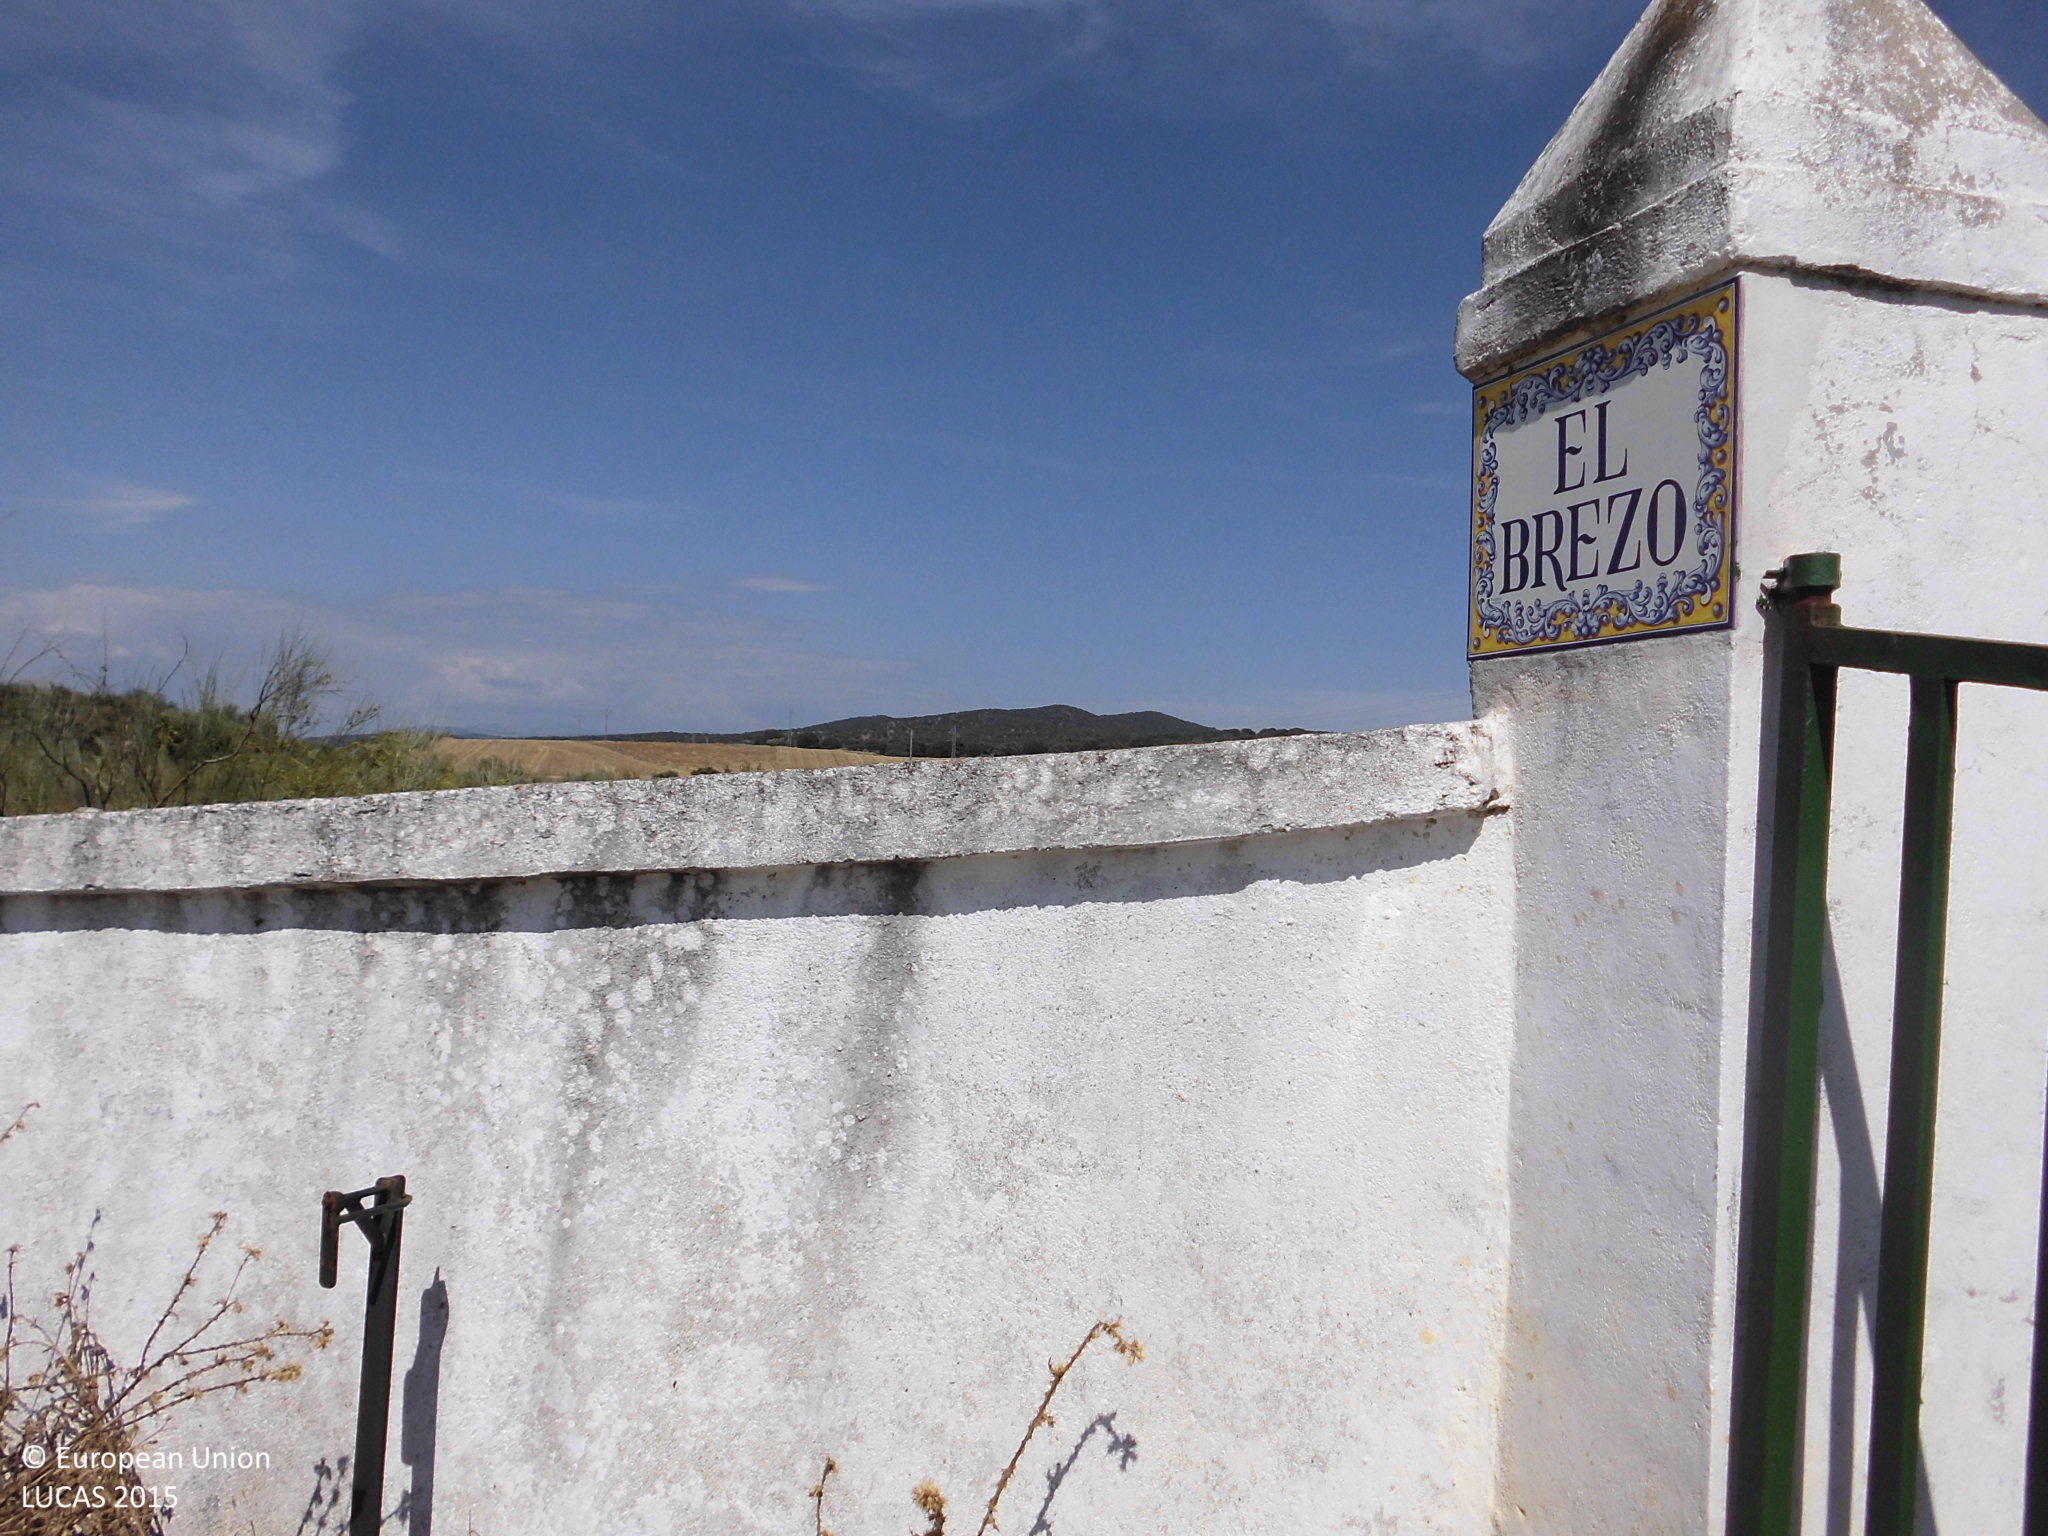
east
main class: Woodland
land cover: Broadleaved woodland
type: broadleaved evergreen forest
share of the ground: 50 - 75 %
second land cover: Grassland without tree/shrub cover
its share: > 75 %
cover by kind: broadleaved forest trees 50 %, herbaceous plants 50 %
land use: Forestry
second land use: Agriculture (excluding fallow land and kitchen gardens)
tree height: > 5 m
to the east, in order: Broadleaved woodland; Grassland without tree/shrub cover; Broadleaved woodland
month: June
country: ES
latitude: 39.9223
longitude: -6.2064
